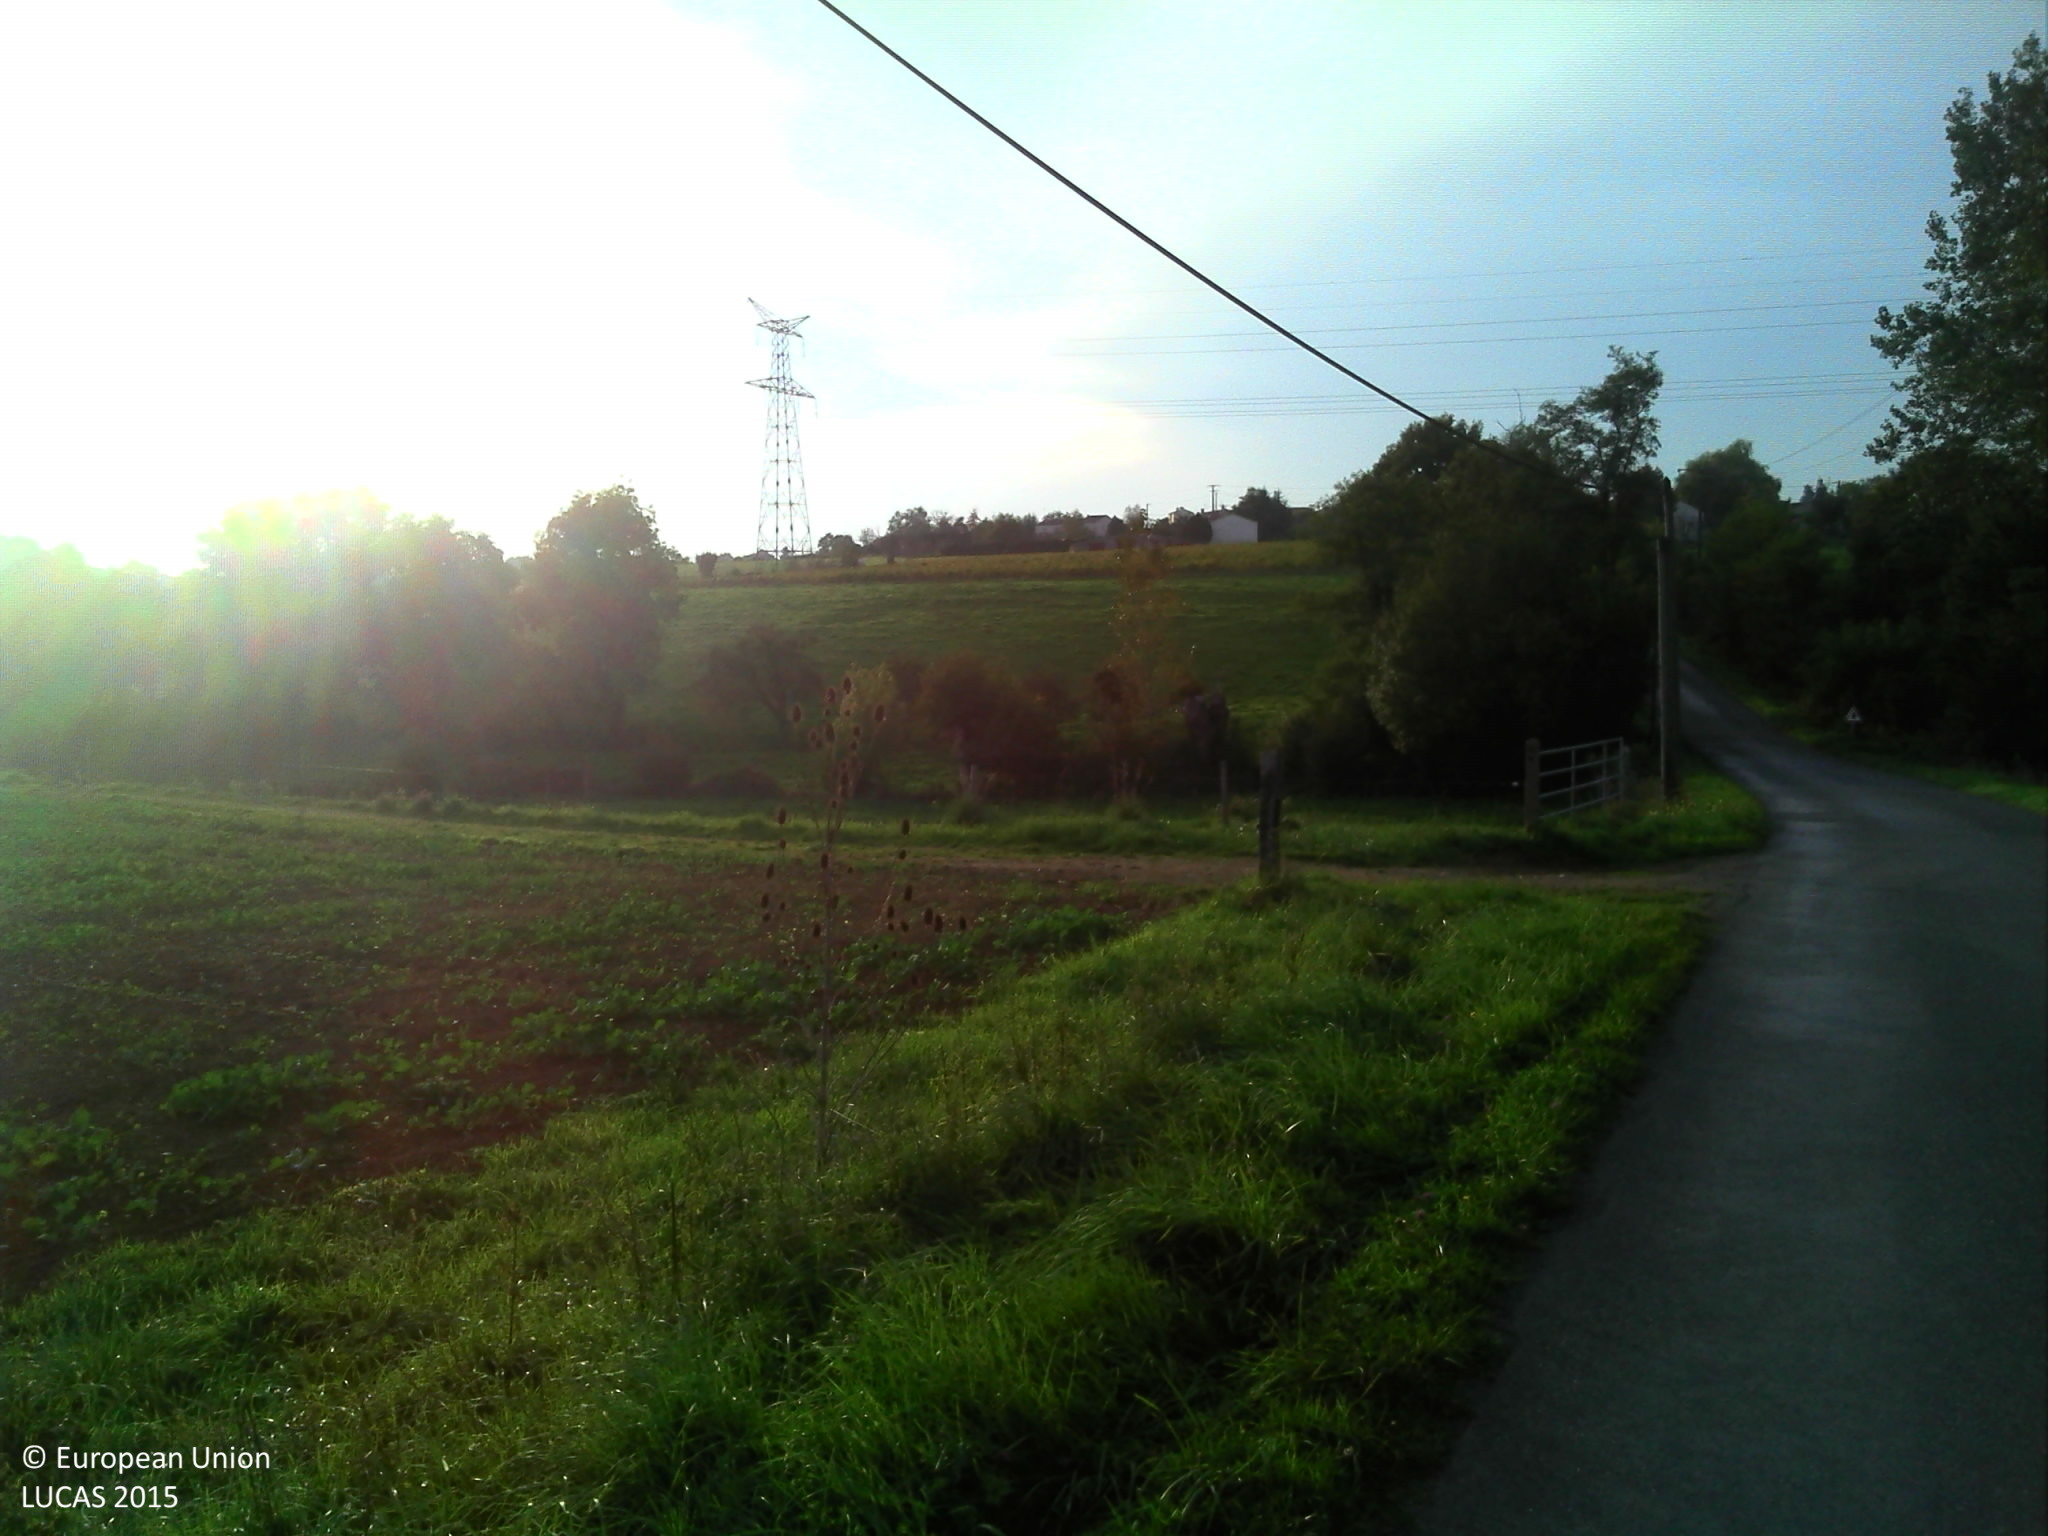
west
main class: Cropland
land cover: Maize
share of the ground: > 75 %
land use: Agriculture (excluding fallow land and kitchen gardens)
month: October
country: FR
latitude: 47.1033
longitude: -1.2243
